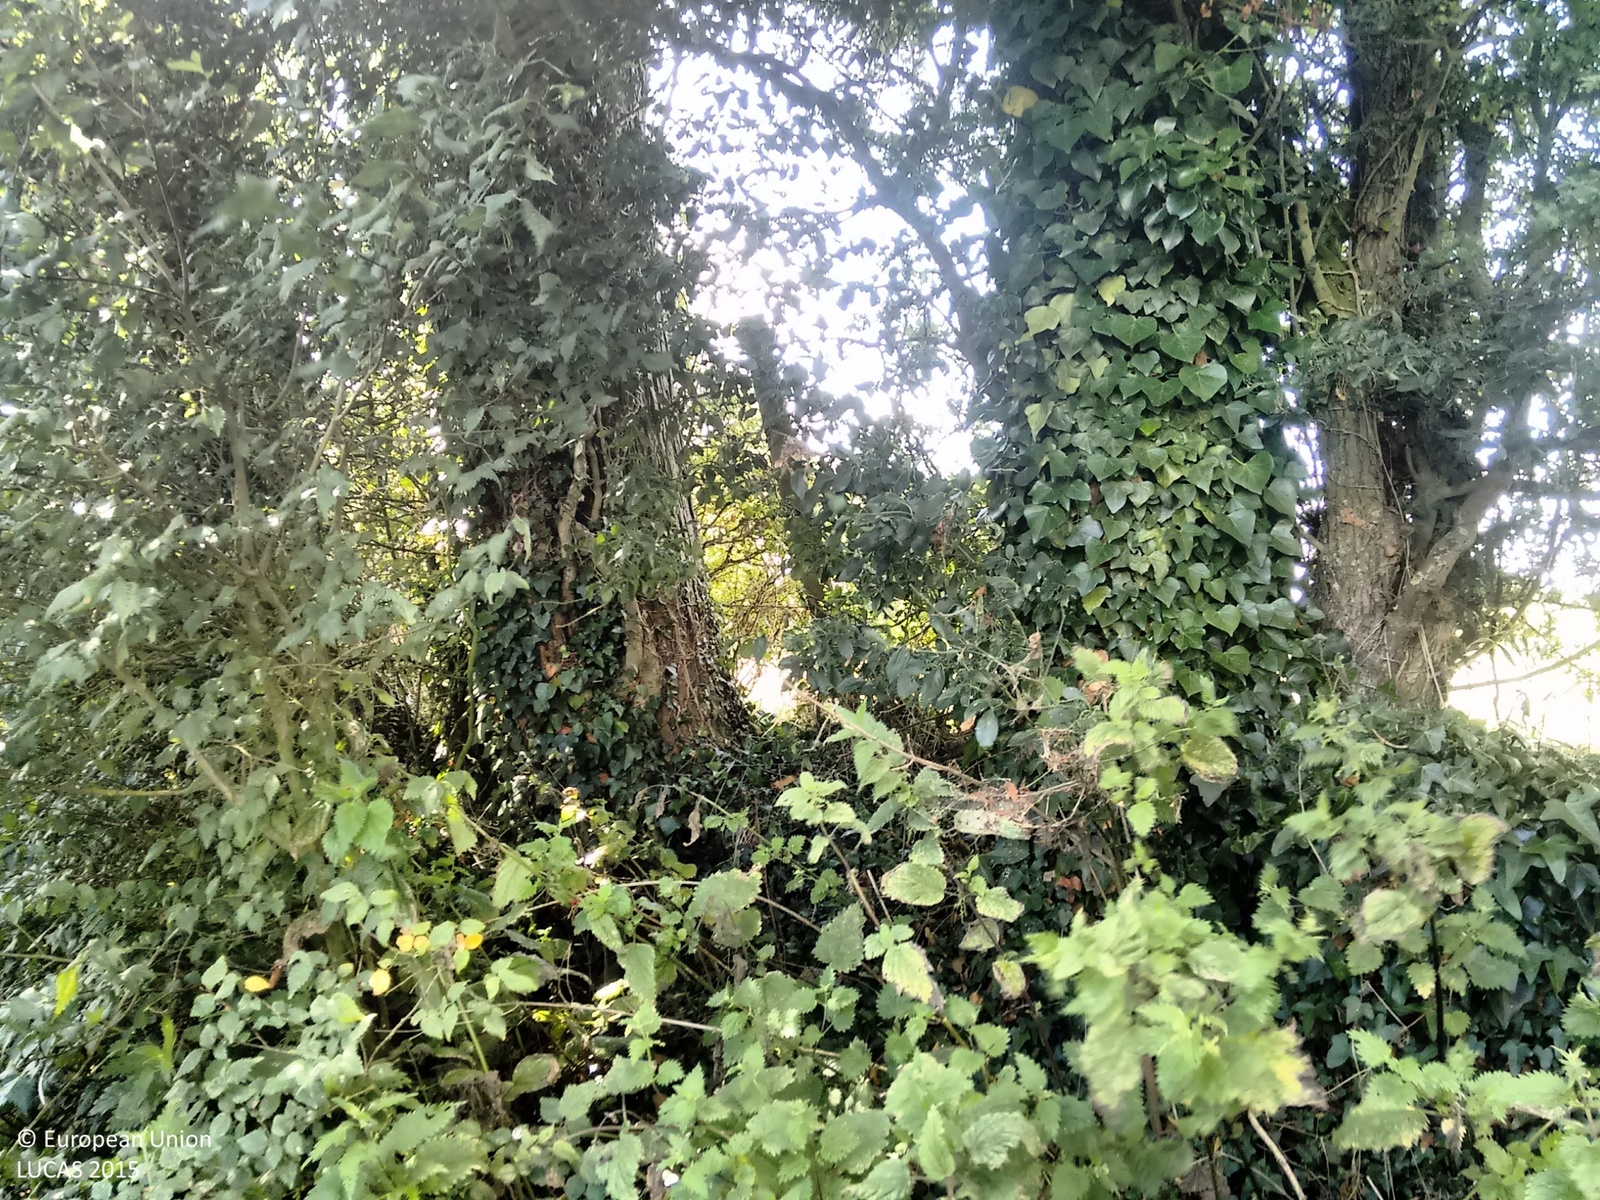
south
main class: Grassland
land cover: Grassland without tree/shrub cover
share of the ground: > 75 %
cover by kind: herbaceous plants 100 %
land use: Agriculture (excluding fallow land and kitchen gardens)
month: August
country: GB
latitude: 52.0591
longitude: 0.3888
